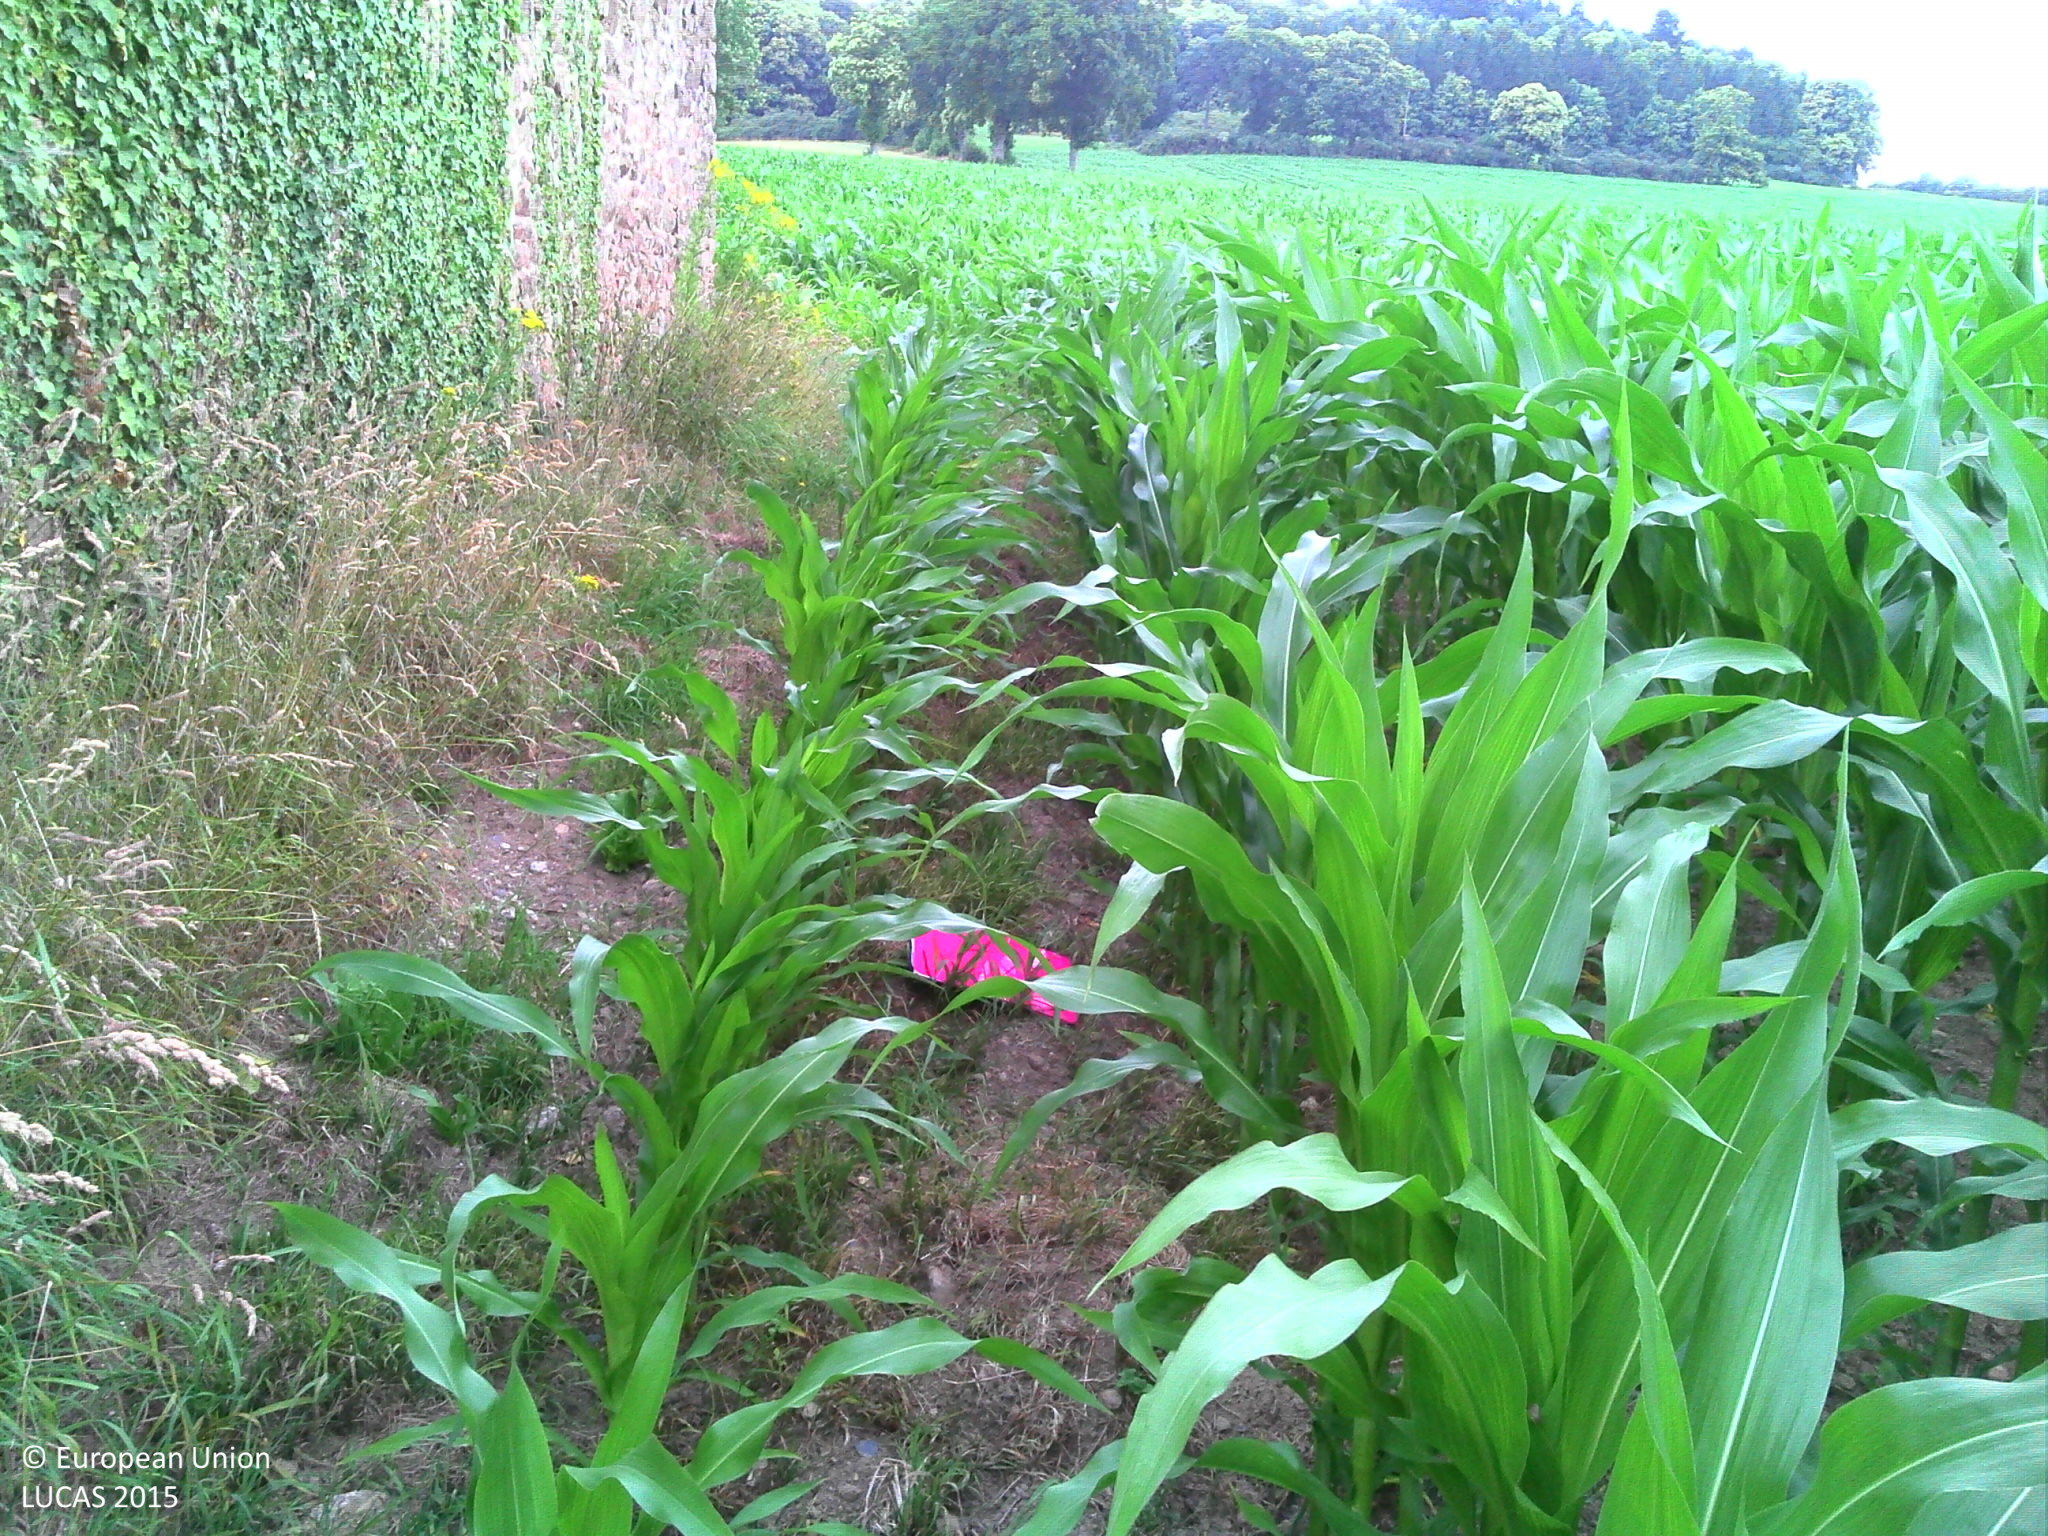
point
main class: Cropland
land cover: Maize
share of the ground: > 75 %
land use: Agriculture (excluding fallow land and kitchen gardens)
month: July
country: FR
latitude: 48.2728
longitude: -1.1576
